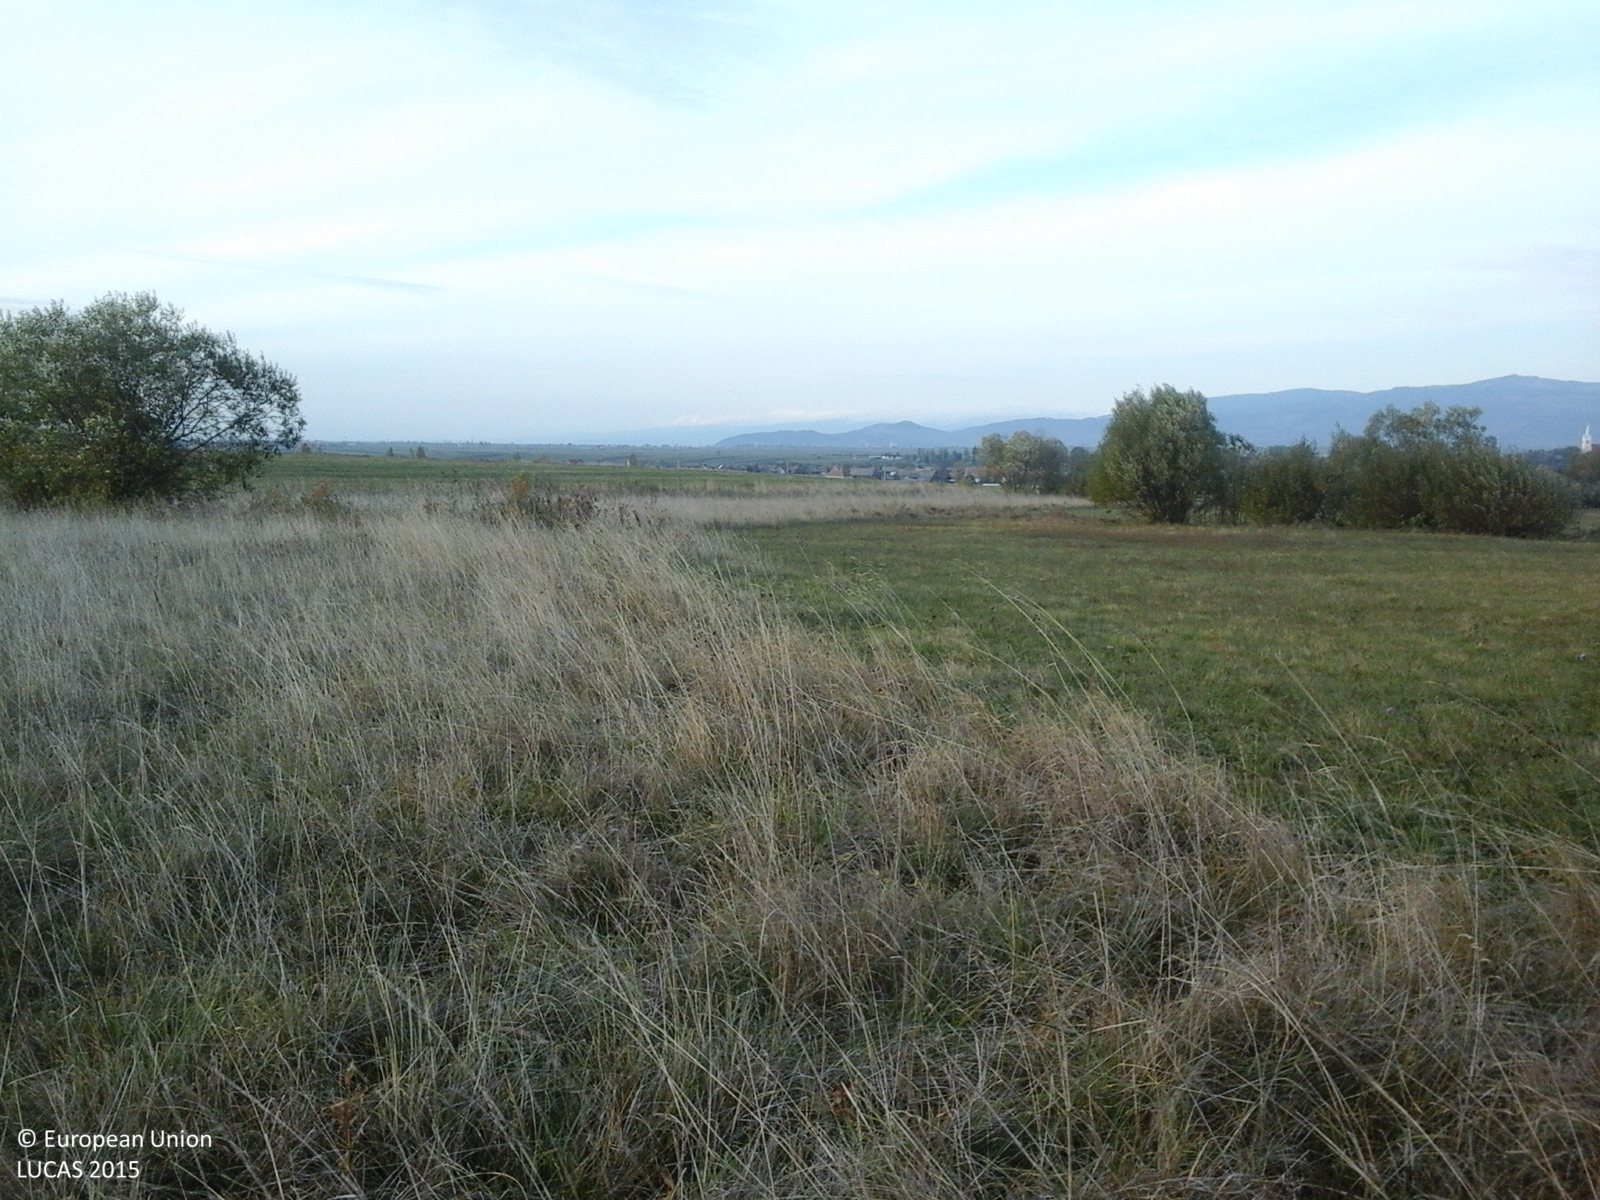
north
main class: Grassland
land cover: Grassland without tree/shrub cover
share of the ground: > 75 %
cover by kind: herbaceous plants 100 %
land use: Agriculture (excluding fallow land and kitchen gardens)
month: October
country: RO
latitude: 46.6541
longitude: 25.5434
